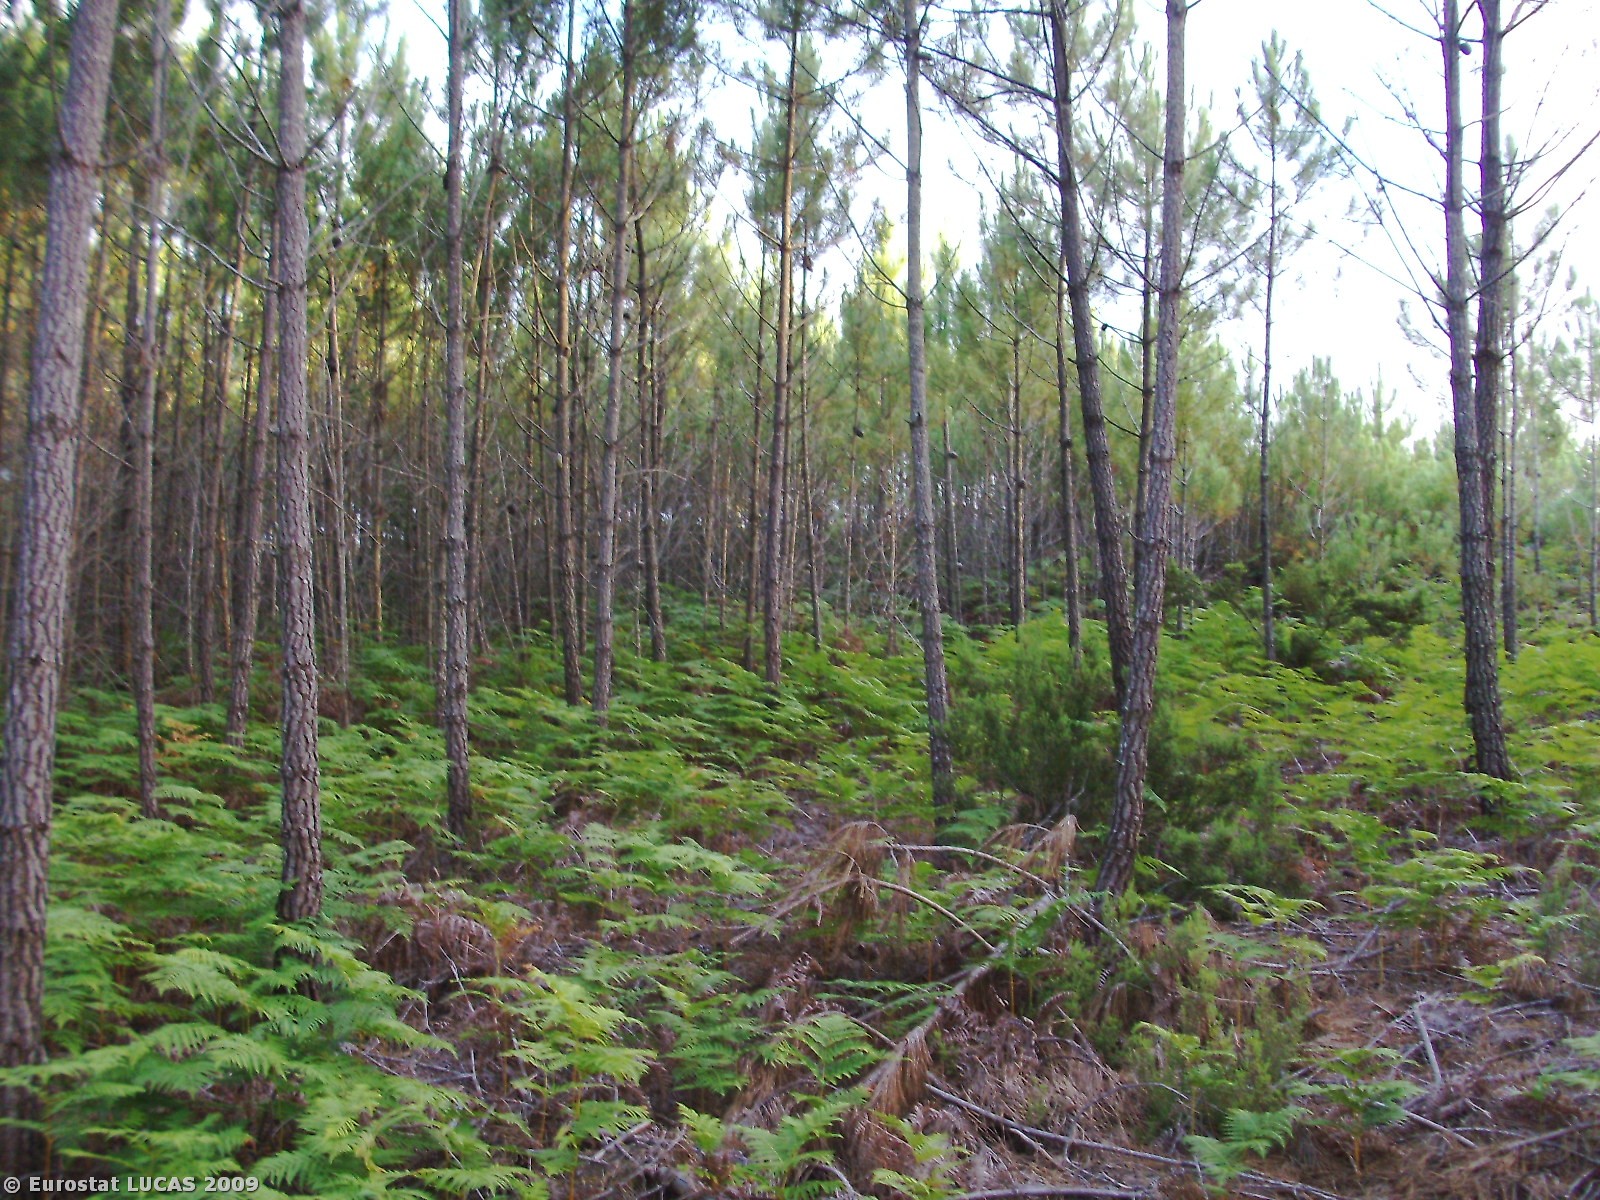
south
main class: Woodland
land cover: Coniferous woodland
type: coniferous forest of the mediterranean region
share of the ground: > 75 %
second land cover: Spontaneously vegetated surfaces
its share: 10 - 25 %
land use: Forestry
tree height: > 5 m
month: July
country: PT
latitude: 39.6630
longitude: -9.0322
